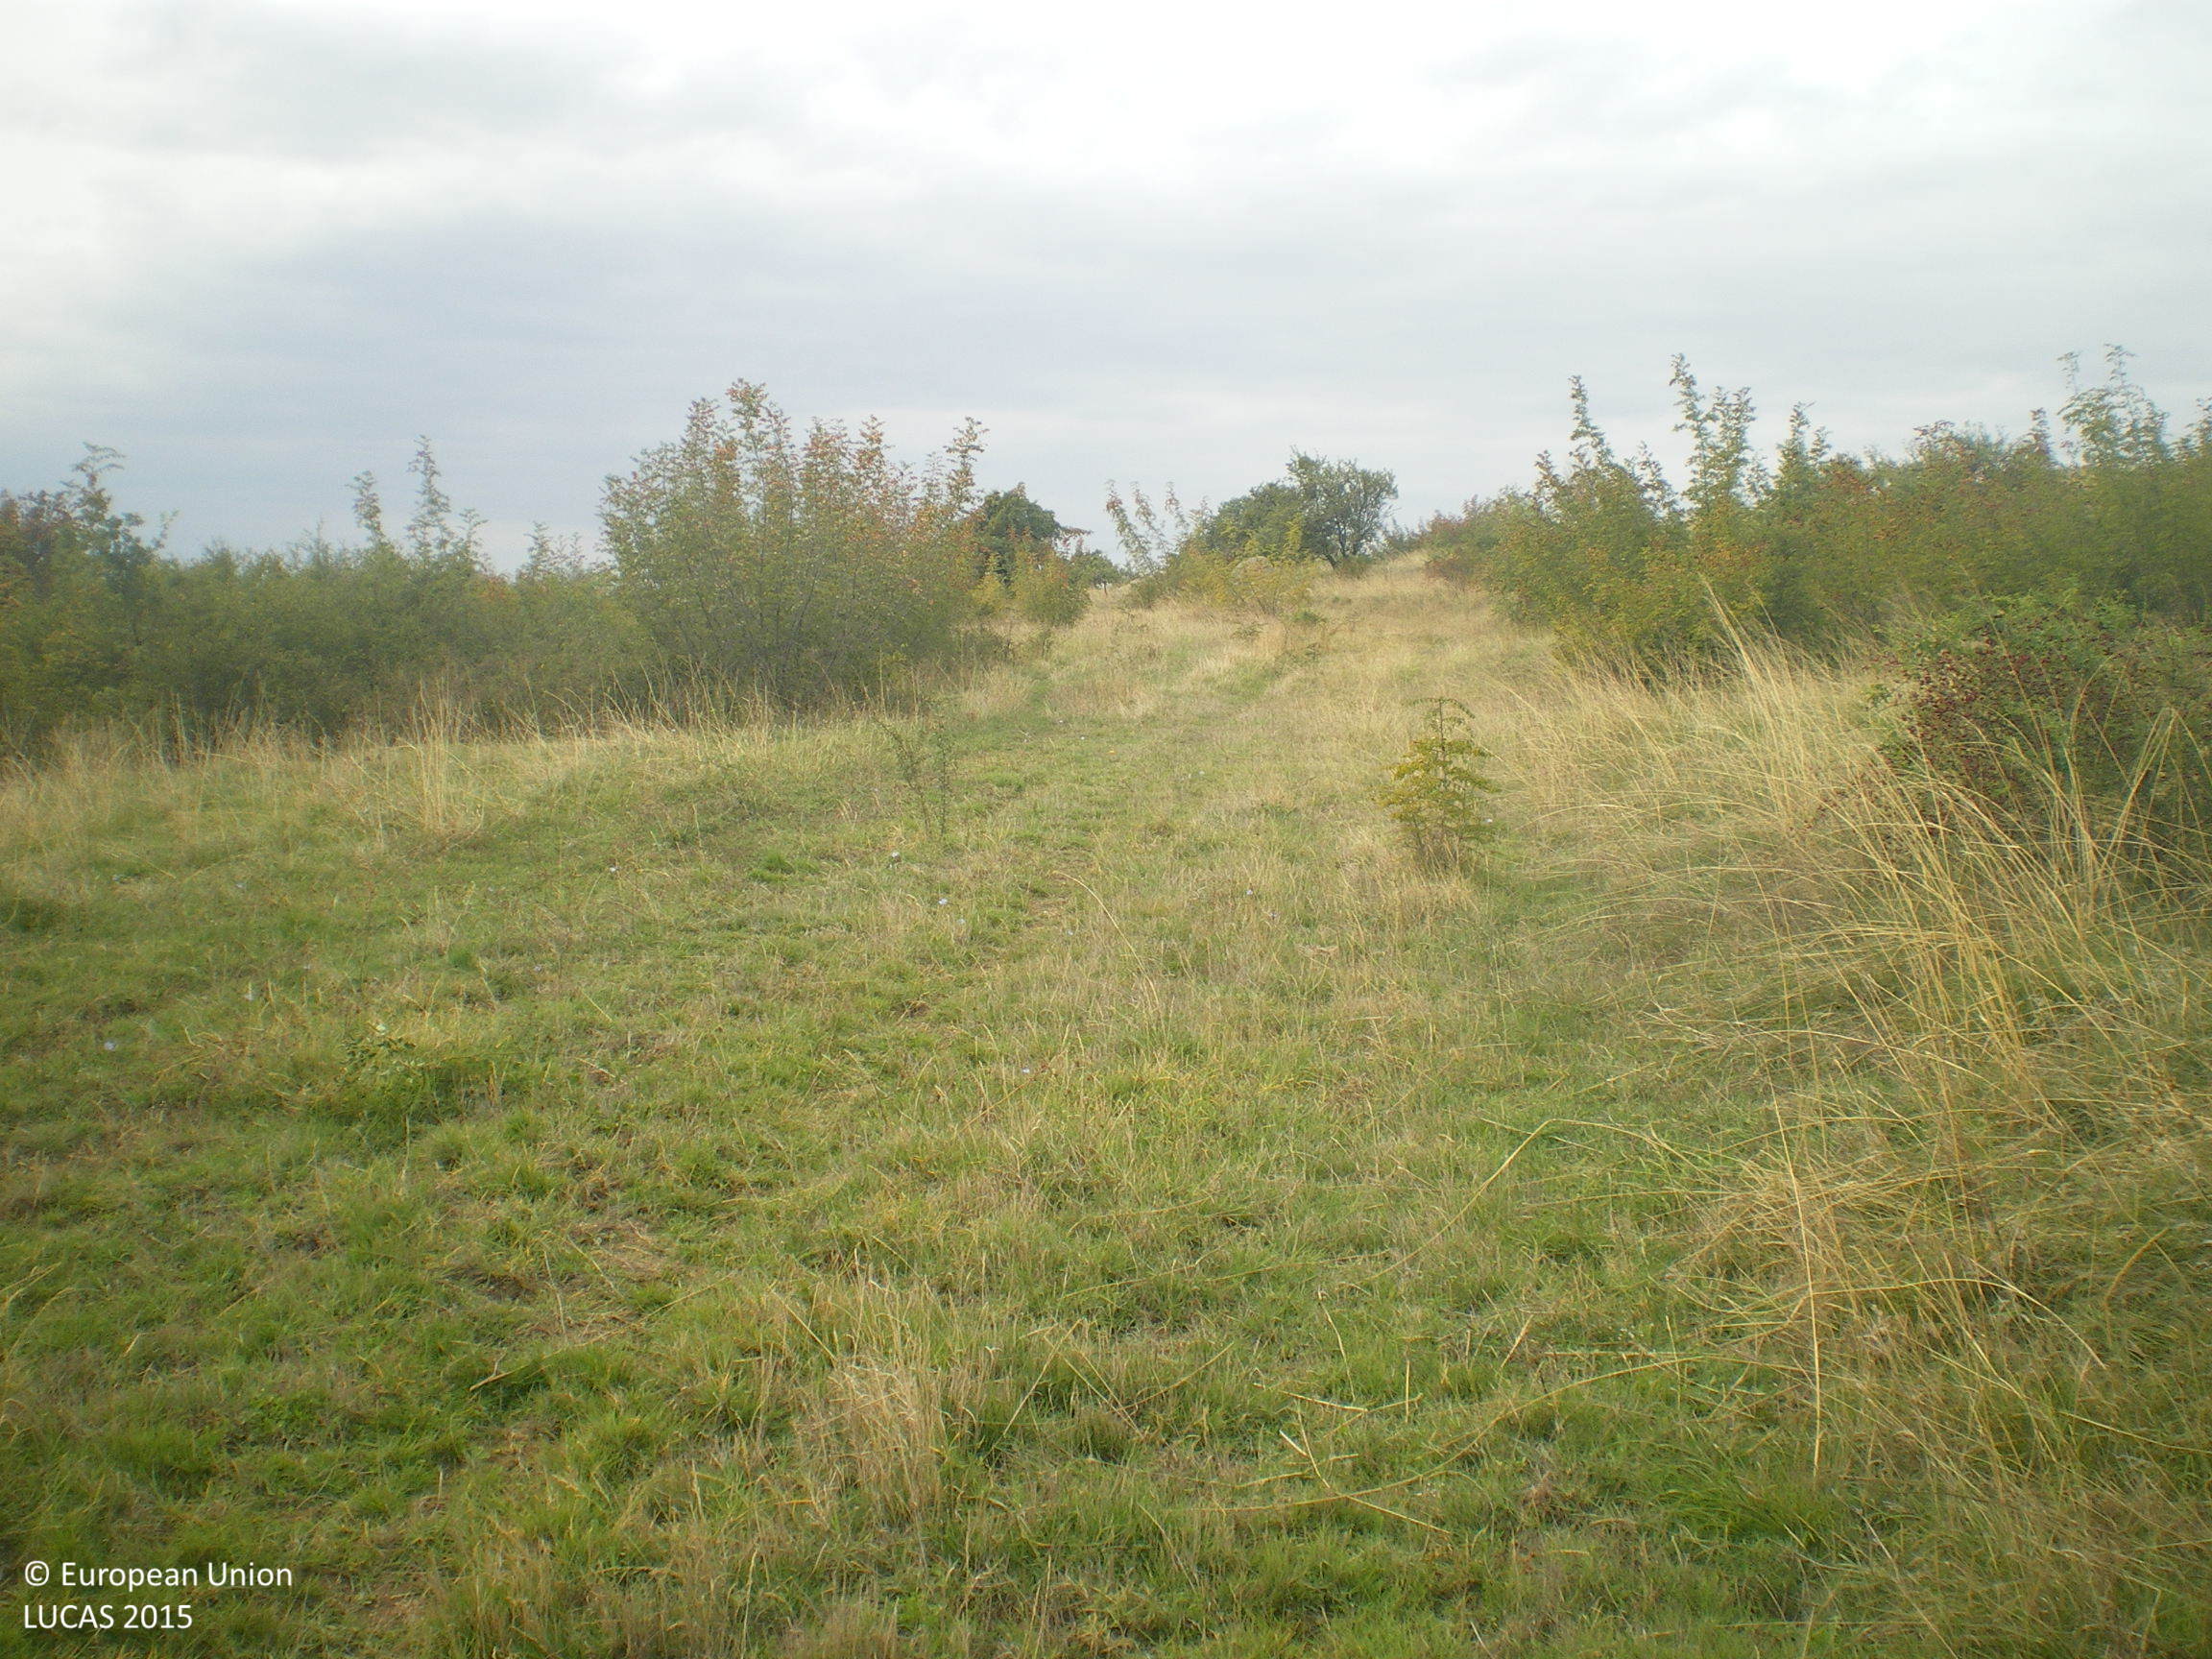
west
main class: Grassland
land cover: Grassland with sparse tree/shrub cover
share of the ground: > 75 %
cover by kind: herbaceous plants 90 %, broadleaved forest trees 5 %, shrubs 5 %
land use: Agriculture (excluding fallow land and kitchen gardens)
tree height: > 5 m
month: October
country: BG
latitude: 41.9317
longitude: 26.1774
